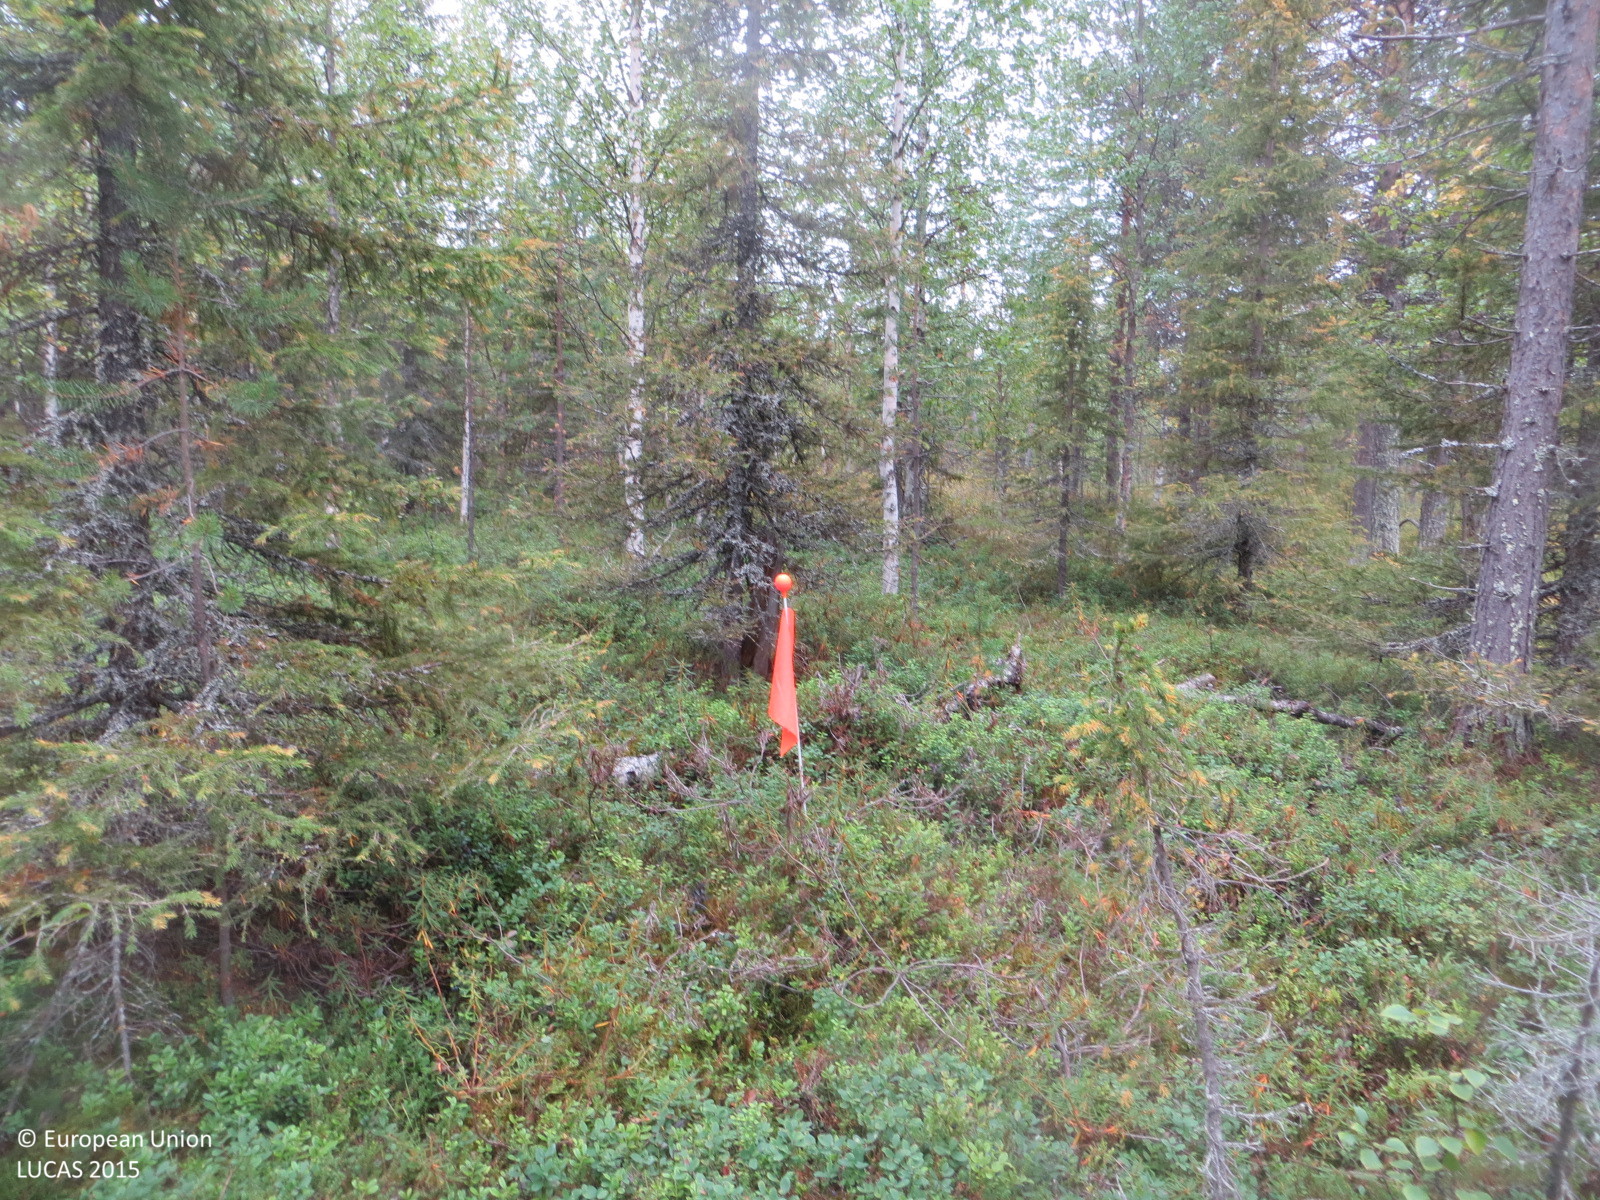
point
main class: Woodland
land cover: Other mixed woodland
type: boreal forest
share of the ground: 50 - 75 %
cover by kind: shrubs 50 %, broadleaved forest trees 30 %, coniferous forest trees 20 %
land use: Forestry
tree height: > 5 m
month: August
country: FI
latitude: 67.5256
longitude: 24.3508
